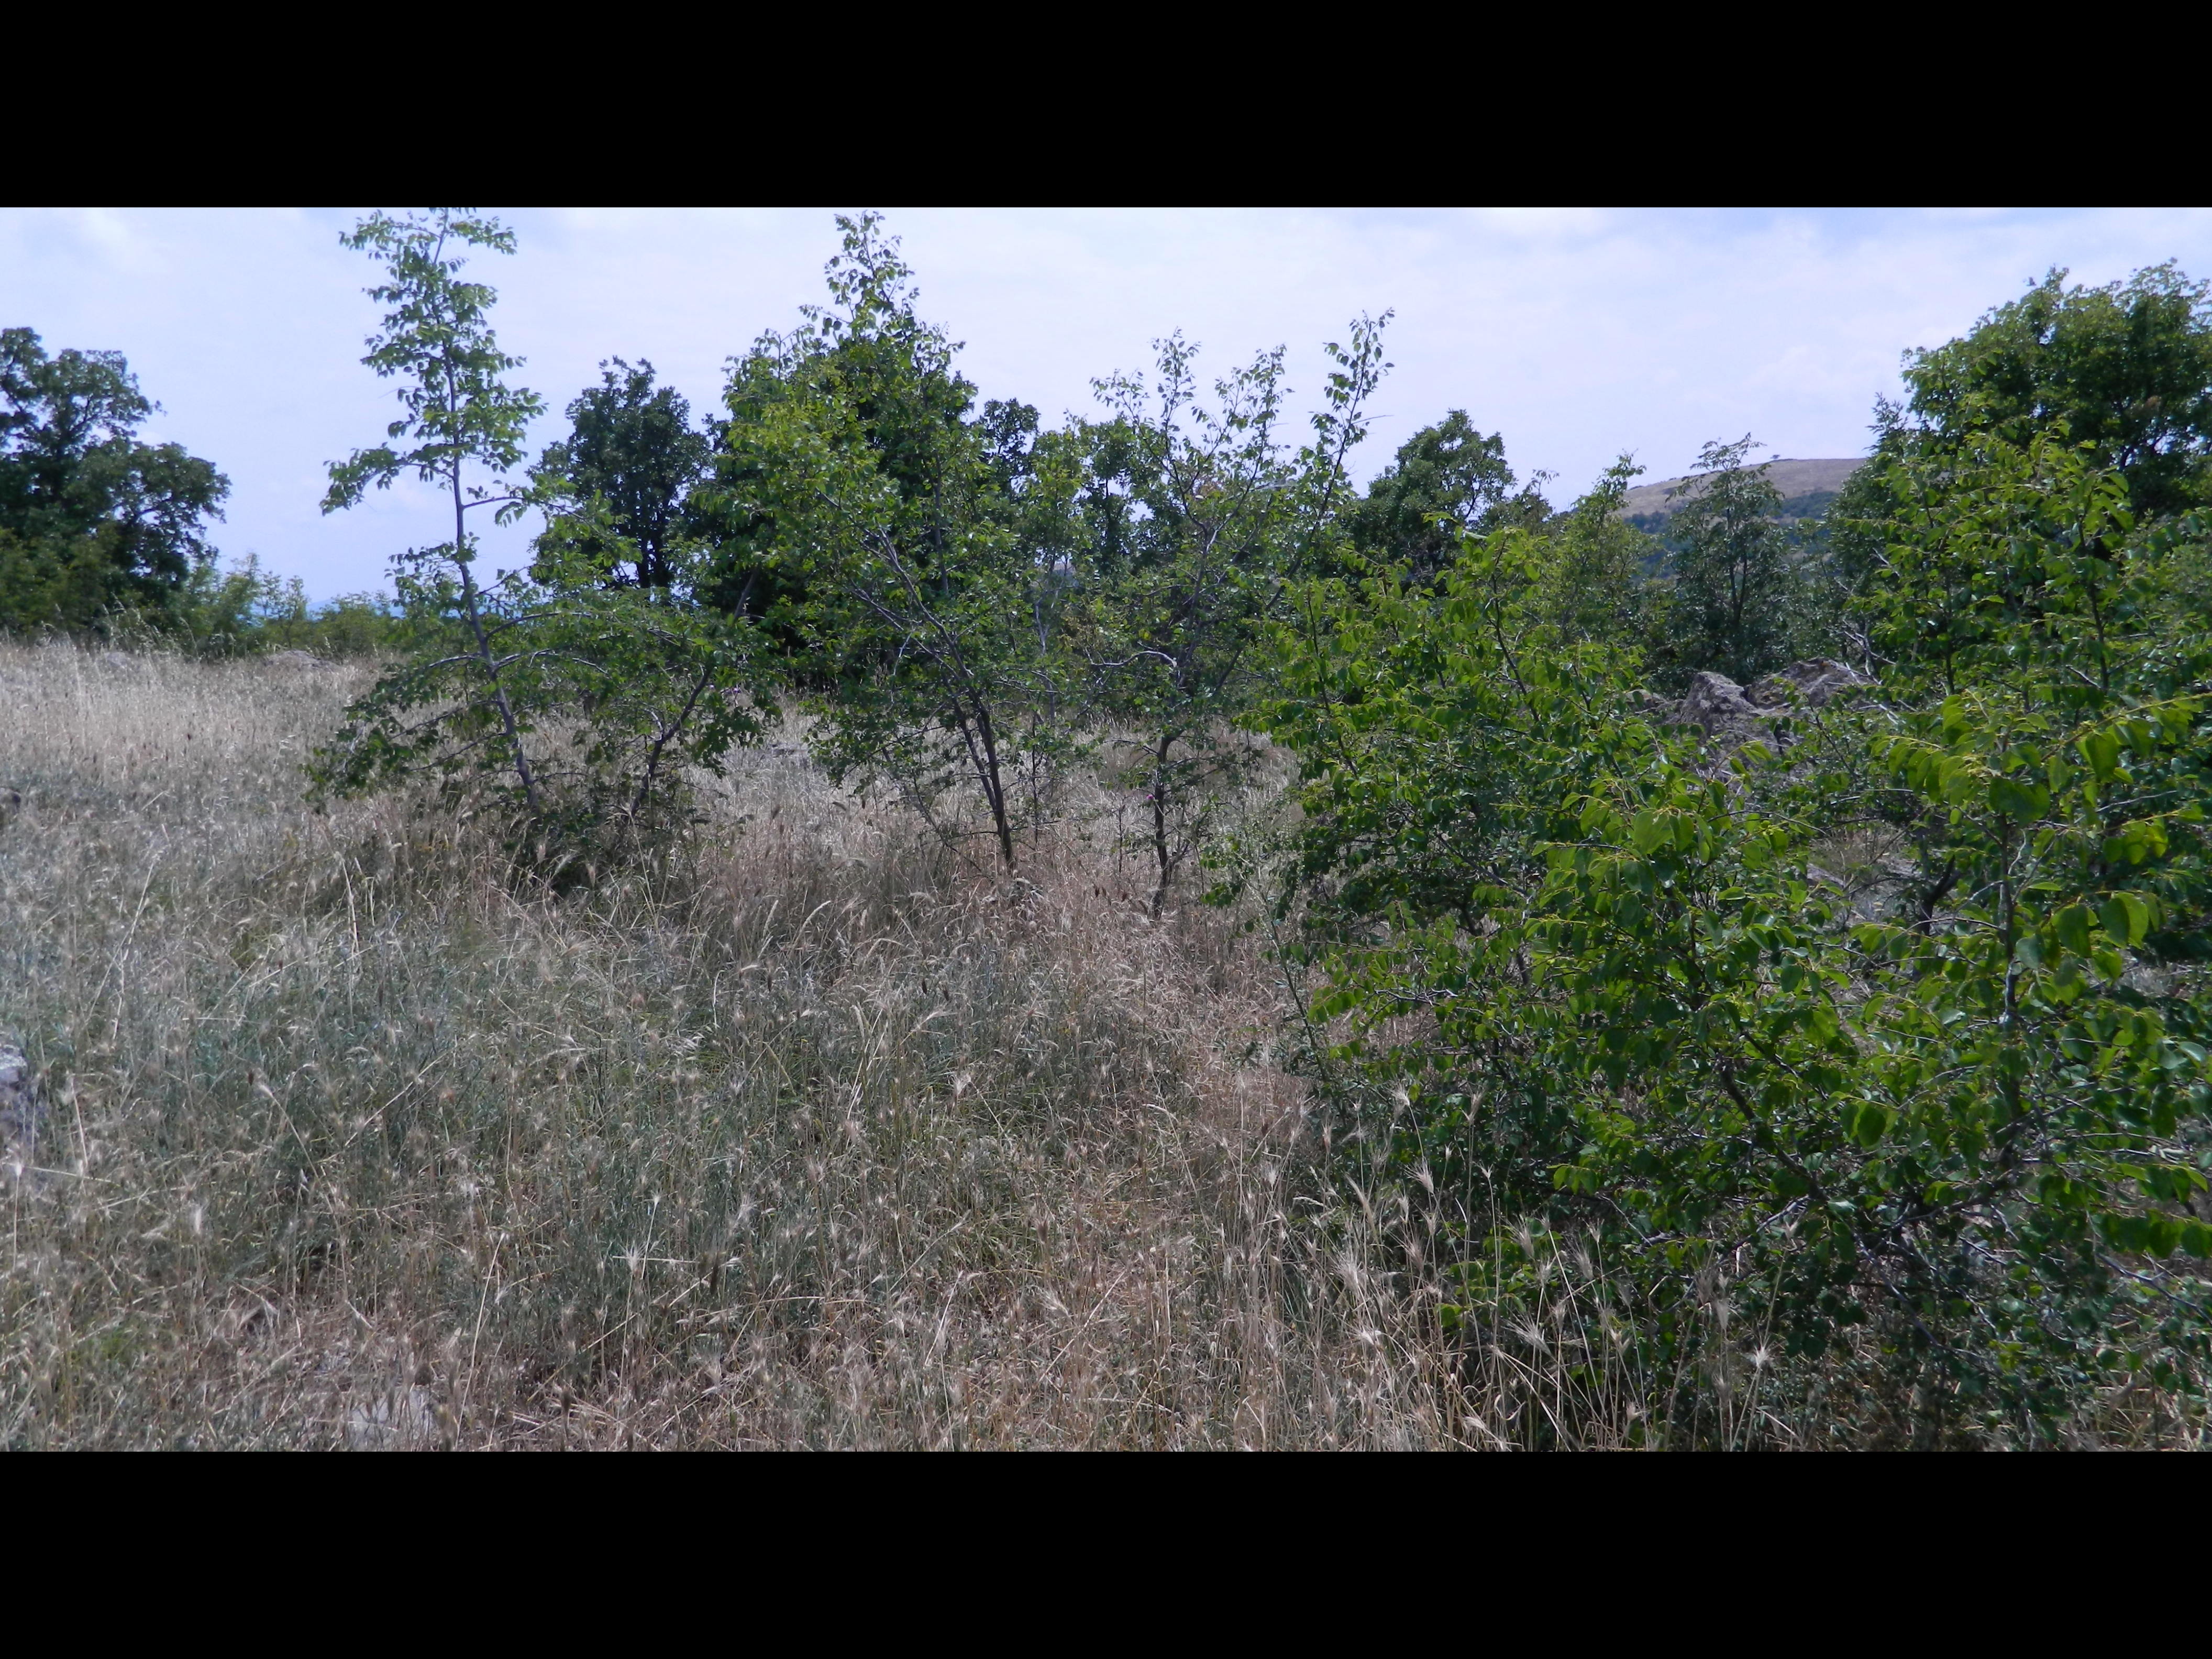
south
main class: Grassland
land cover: Grassland with sparse tree/shrub cover
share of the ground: > 75 %
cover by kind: herbaceous plants 90 %, broadleaved forest trees 5 %, shrubs 5 %
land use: Semi-natural and natural areas not in use
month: June
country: BG
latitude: 41.8794
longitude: 25.3511
